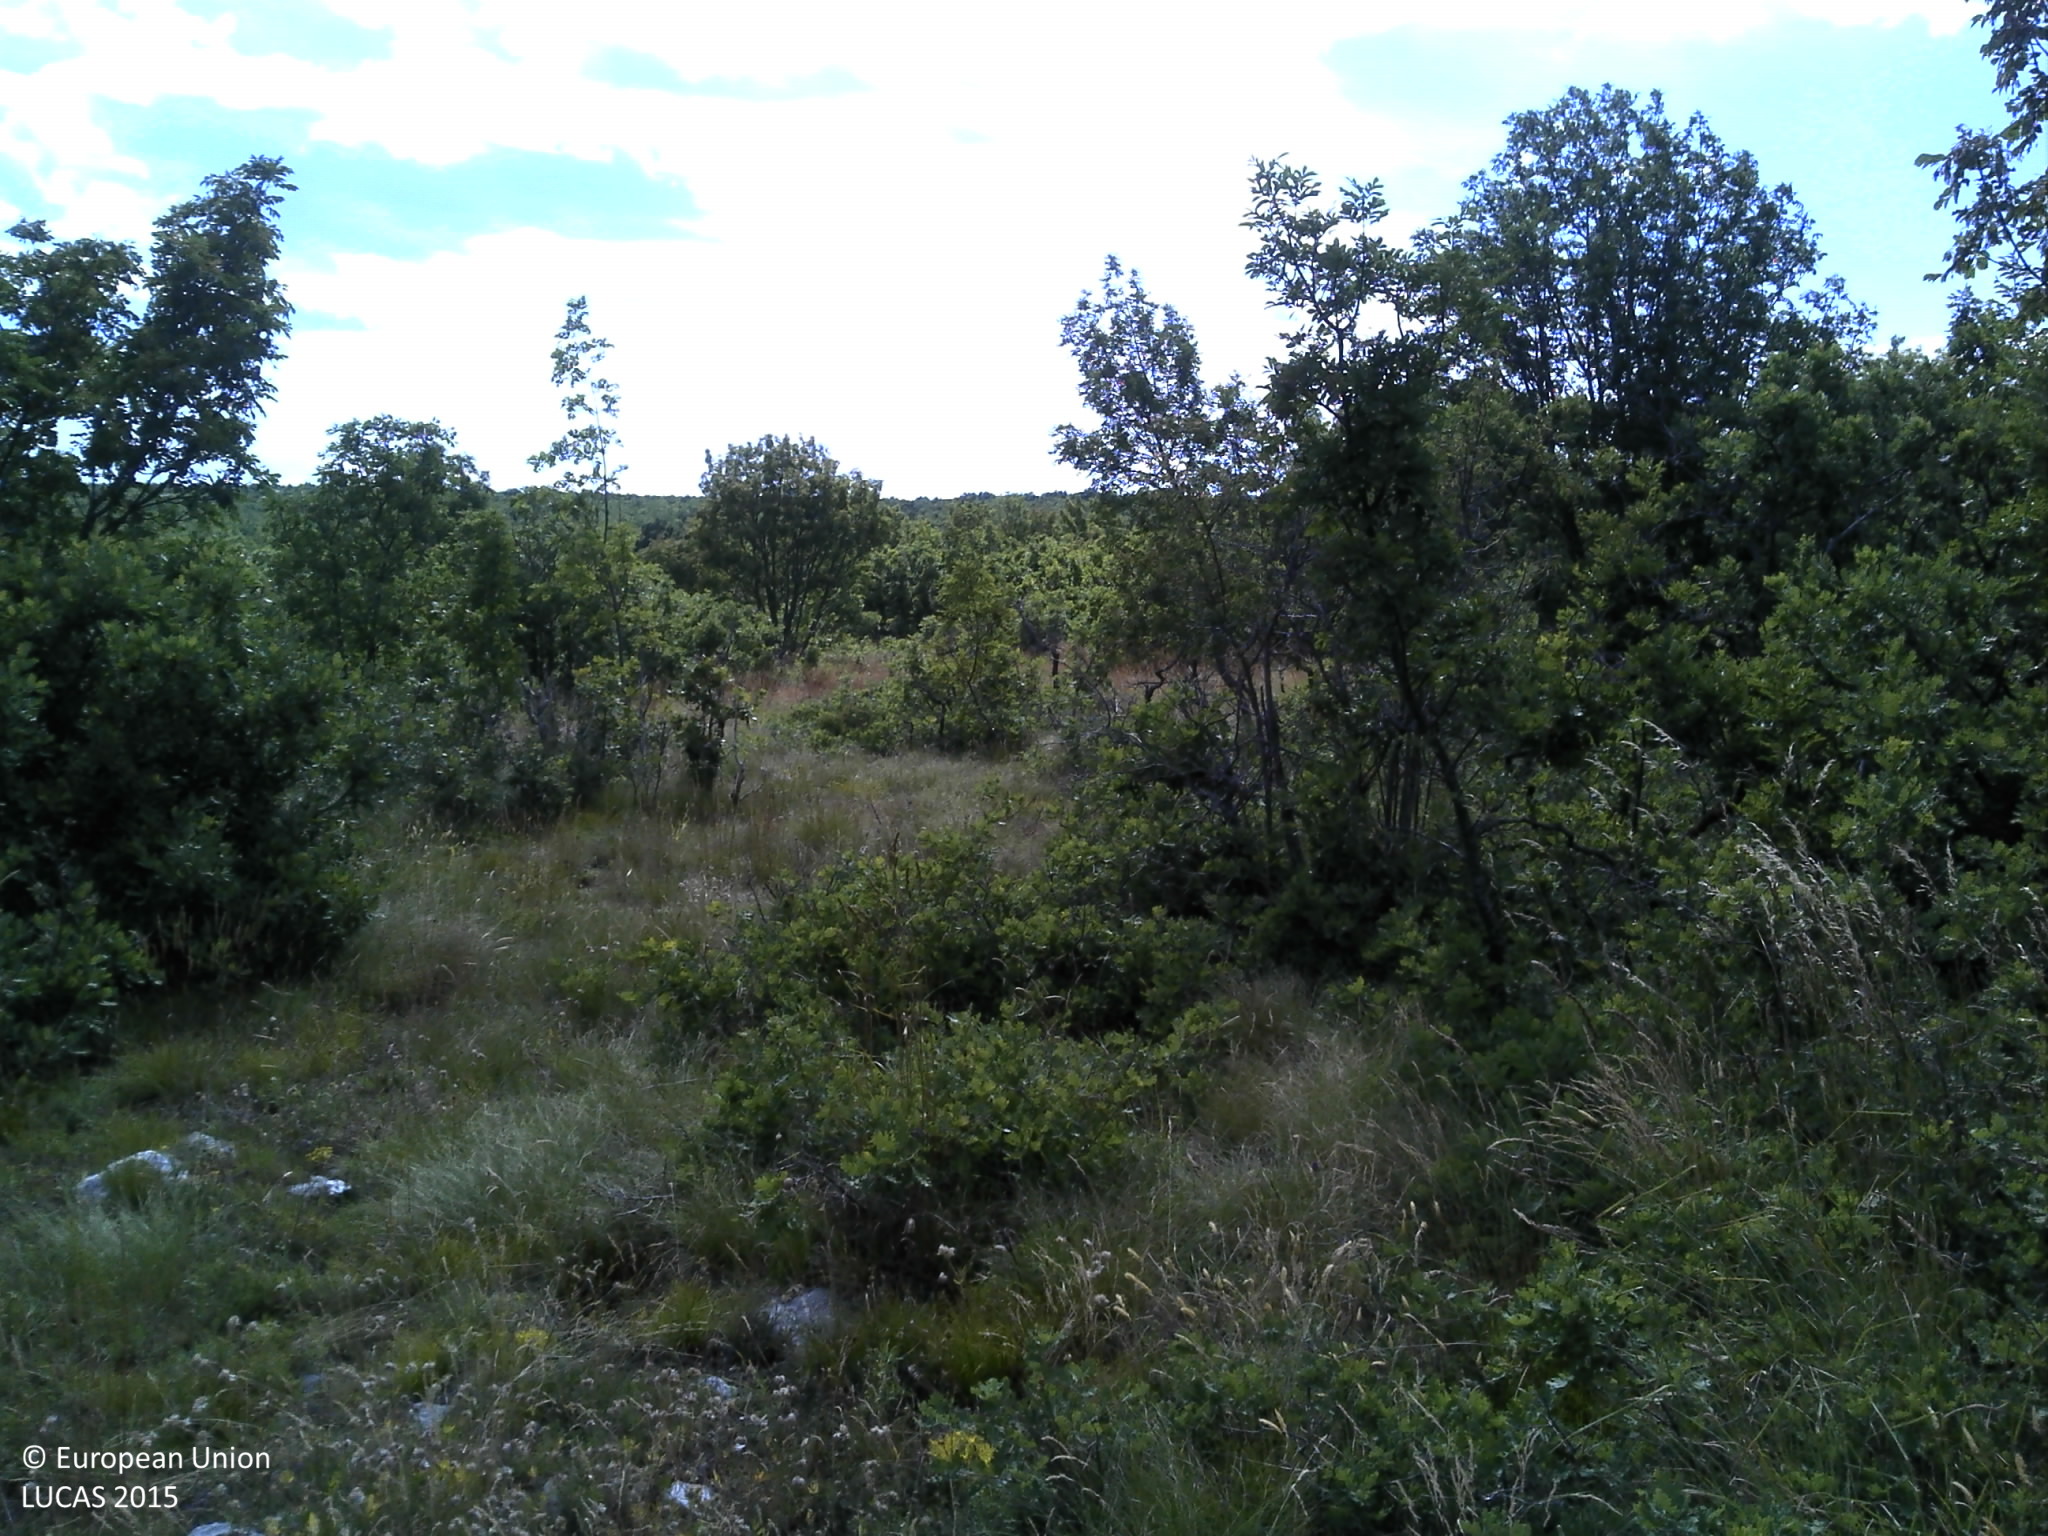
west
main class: Woodland
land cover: Broadleaved woodland
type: thermophilous deciduous forest
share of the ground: 25 - 50 %
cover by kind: broadleaved forest trees 35 %, herbaceous plants 30 %, shrubs 20 %, unconsolidated bare surface 10 %, consolidated bare surface 5 %
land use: Semi-natural and natural areas not in use
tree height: > 5 m
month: June
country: HR
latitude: 43.6110
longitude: 16.9430
